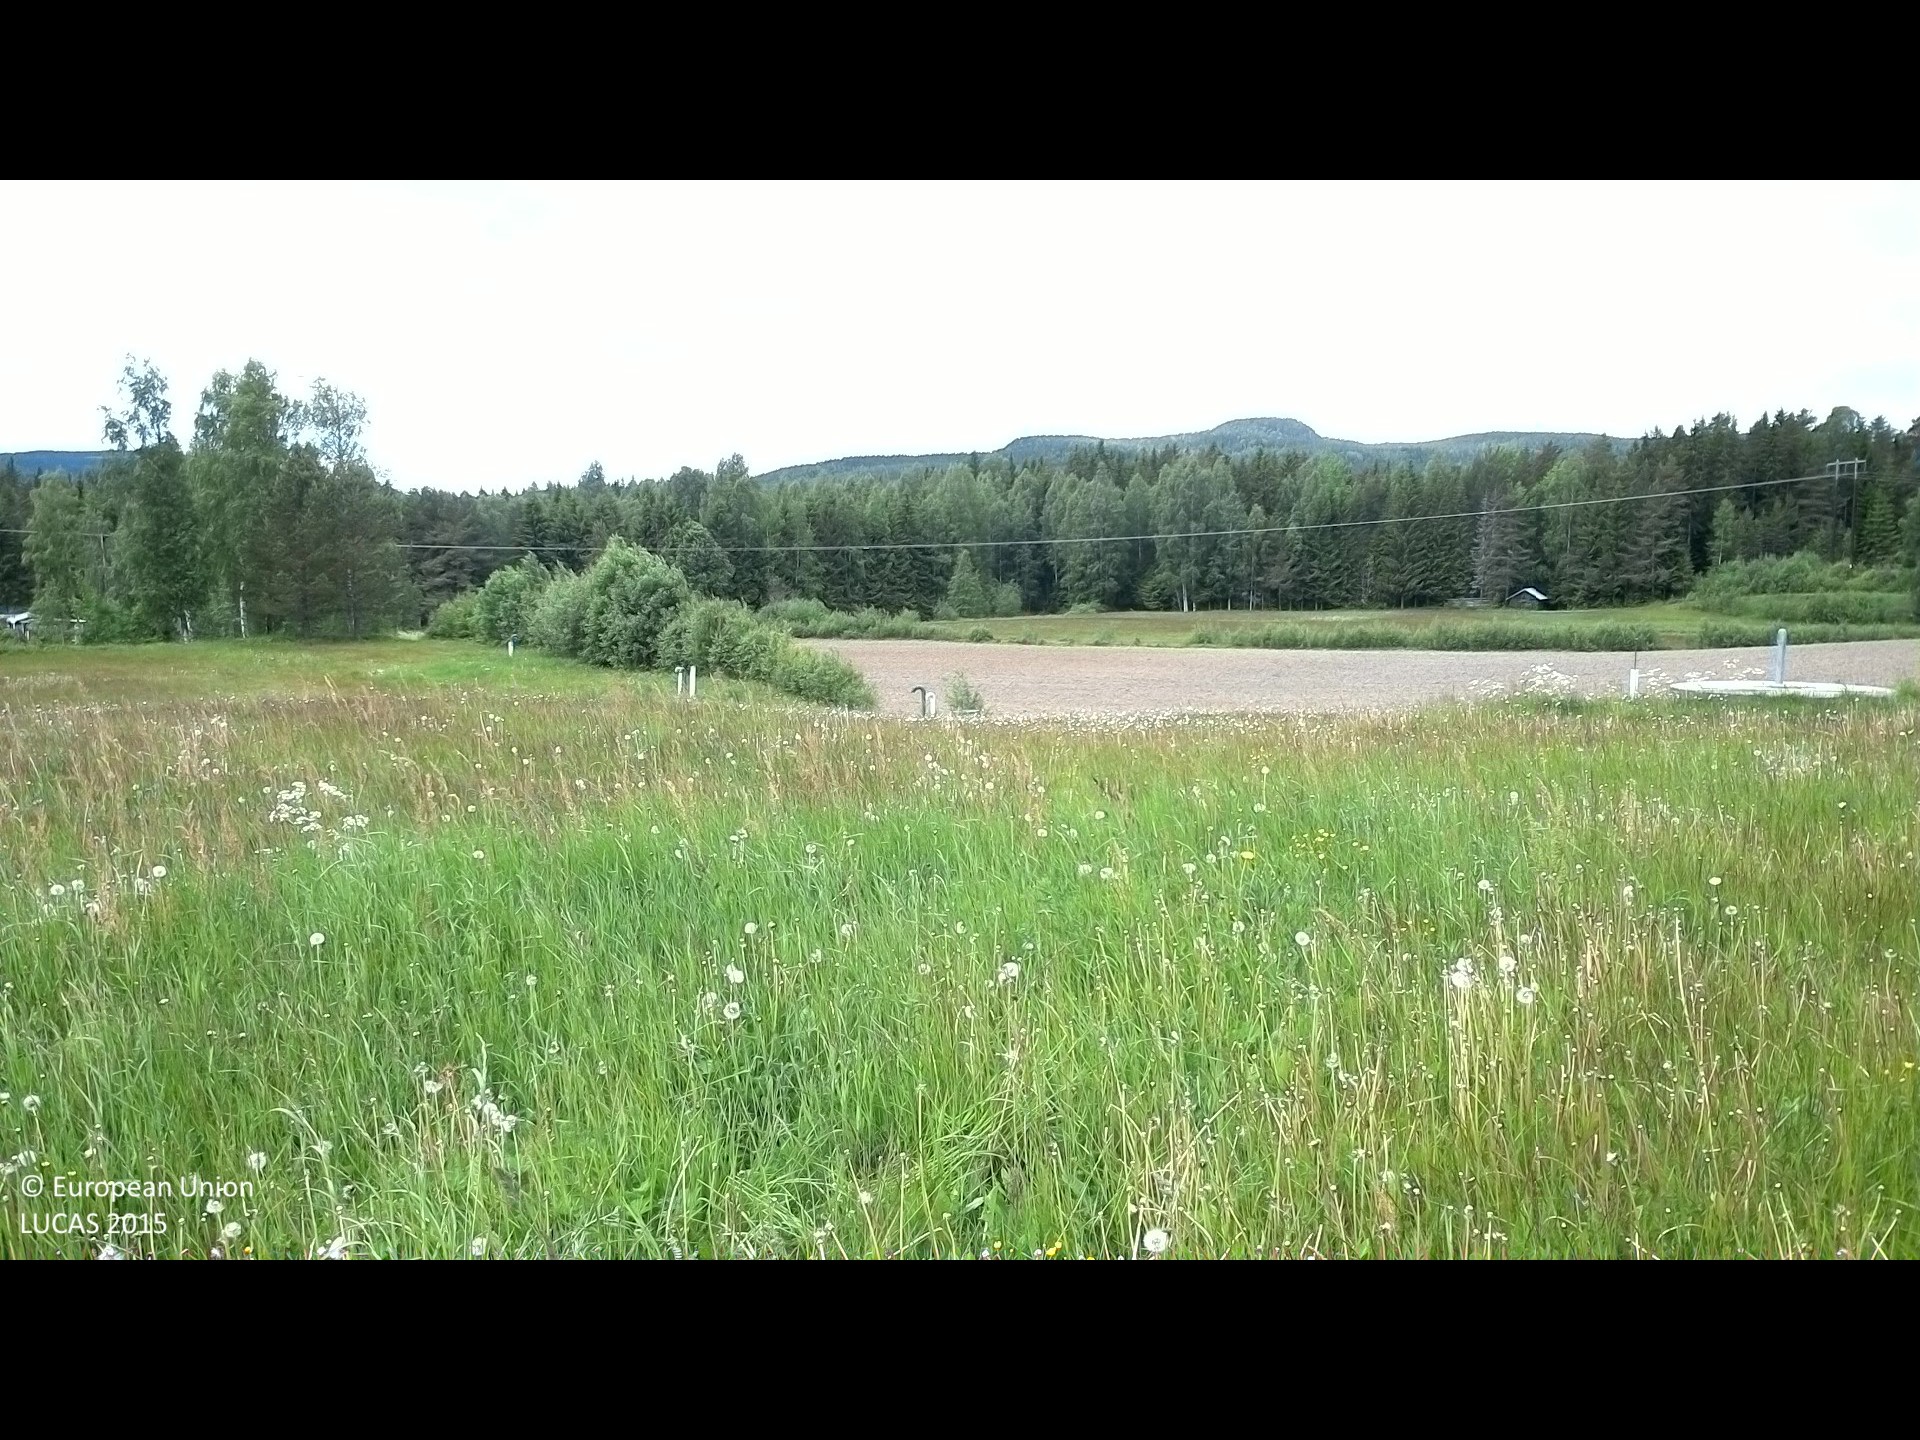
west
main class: Cropland
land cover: Temporary grasslands
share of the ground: > 75 %
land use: Agriculture (excluding fallow land and kitchen gardens)
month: June
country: SE
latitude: 61.9725
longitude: 16.3343
